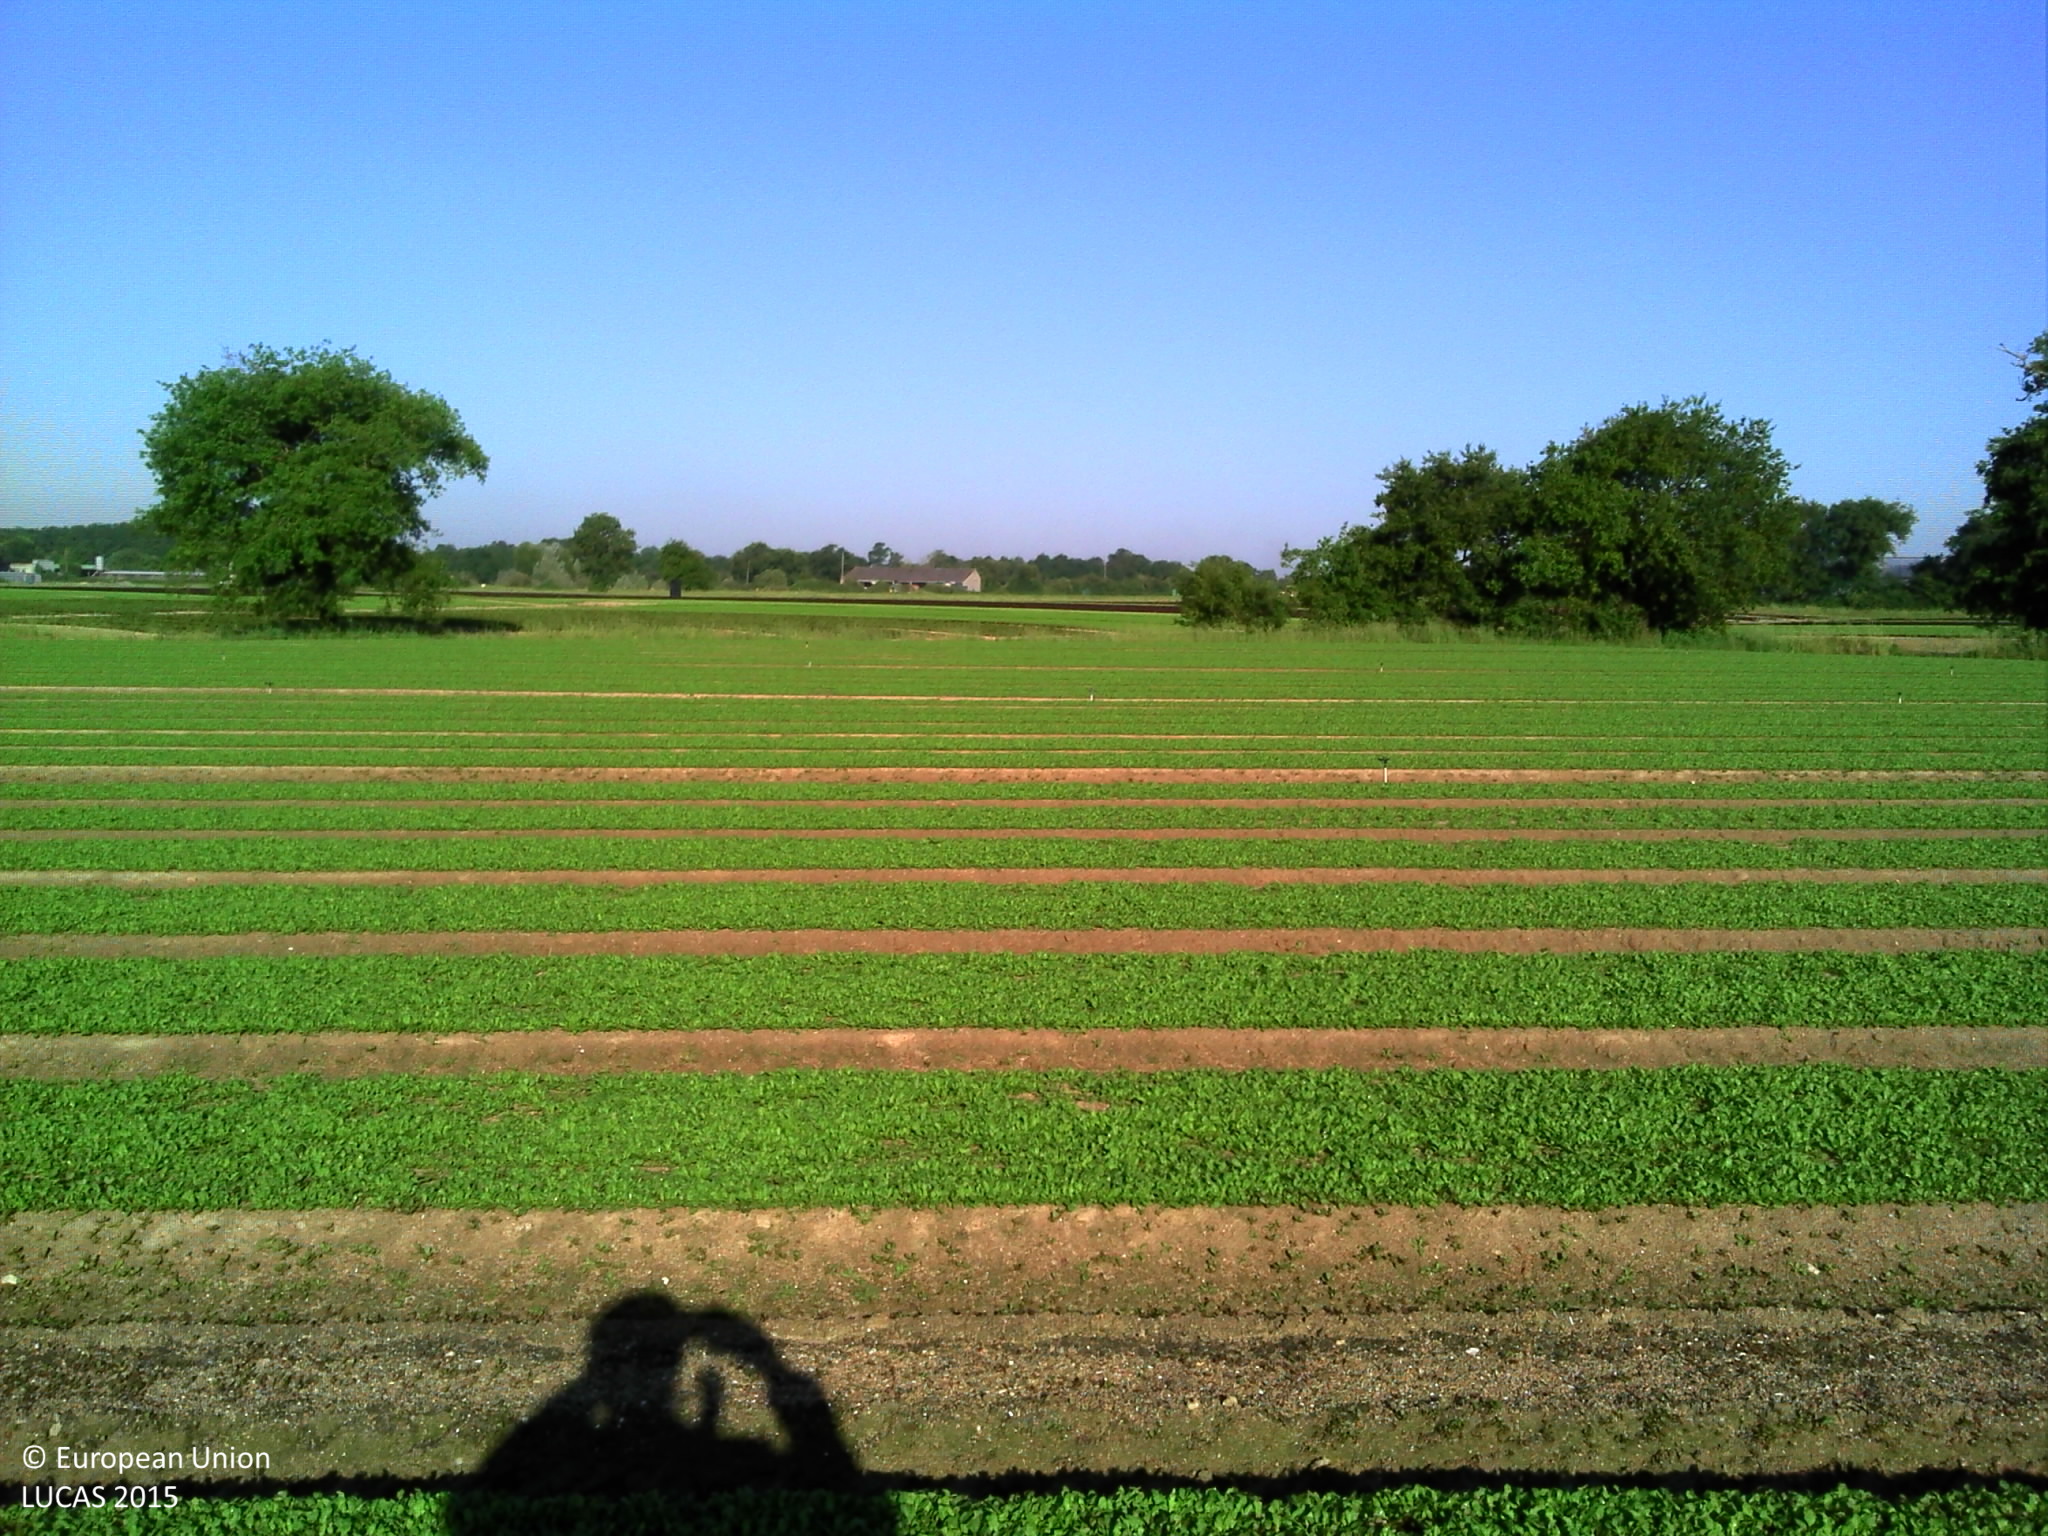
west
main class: Cropland
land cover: Other fresh vegetables
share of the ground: > 75 %
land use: Agriculture (excluding fallow land and kitchen gardens)
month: June
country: FR
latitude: 47.0185
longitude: -1.8456
